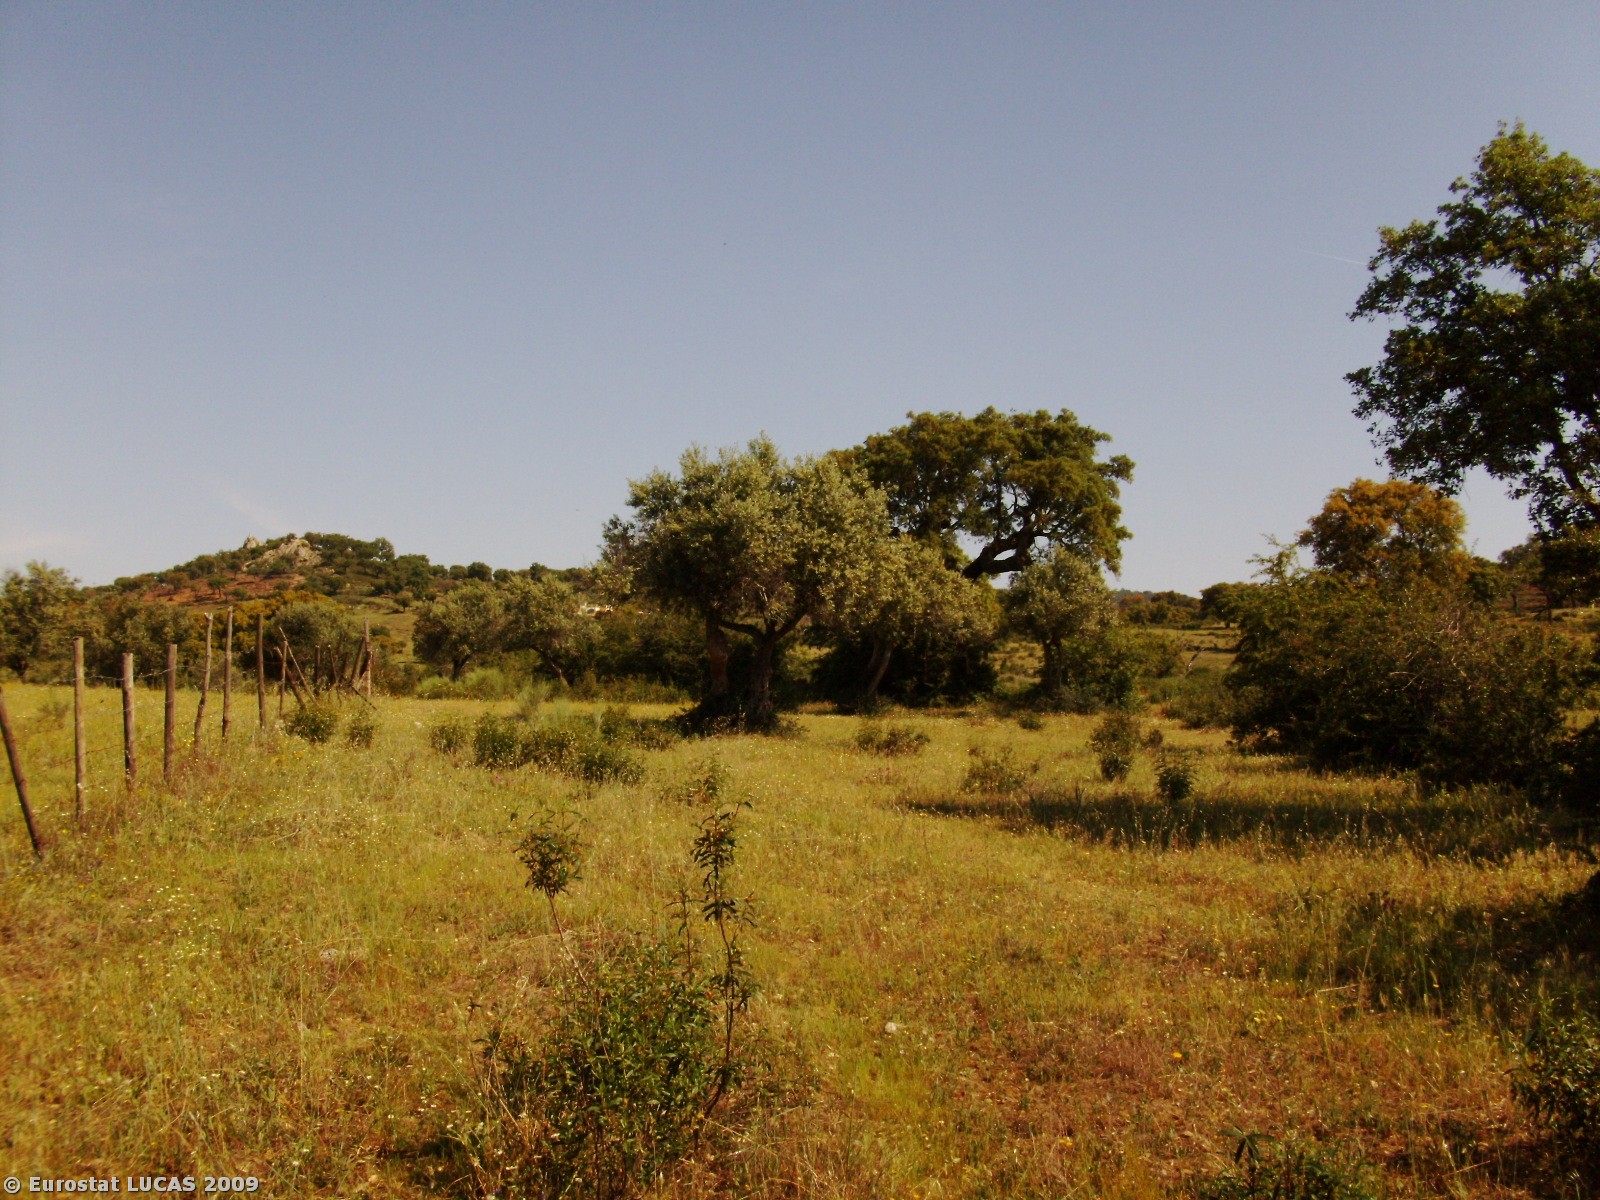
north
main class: Woodland
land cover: Broadleaved woodland
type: broadleaved evergreen forest
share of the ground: 25 - 50 %
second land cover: Grassland with sparse tree/shrub cover
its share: 50 - 75 %
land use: Forestry
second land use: Agriculture (excluding fallow land and kitchen gardens)
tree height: > 5 m
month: May
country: PT
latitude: 39.2685
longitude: -7.4150
